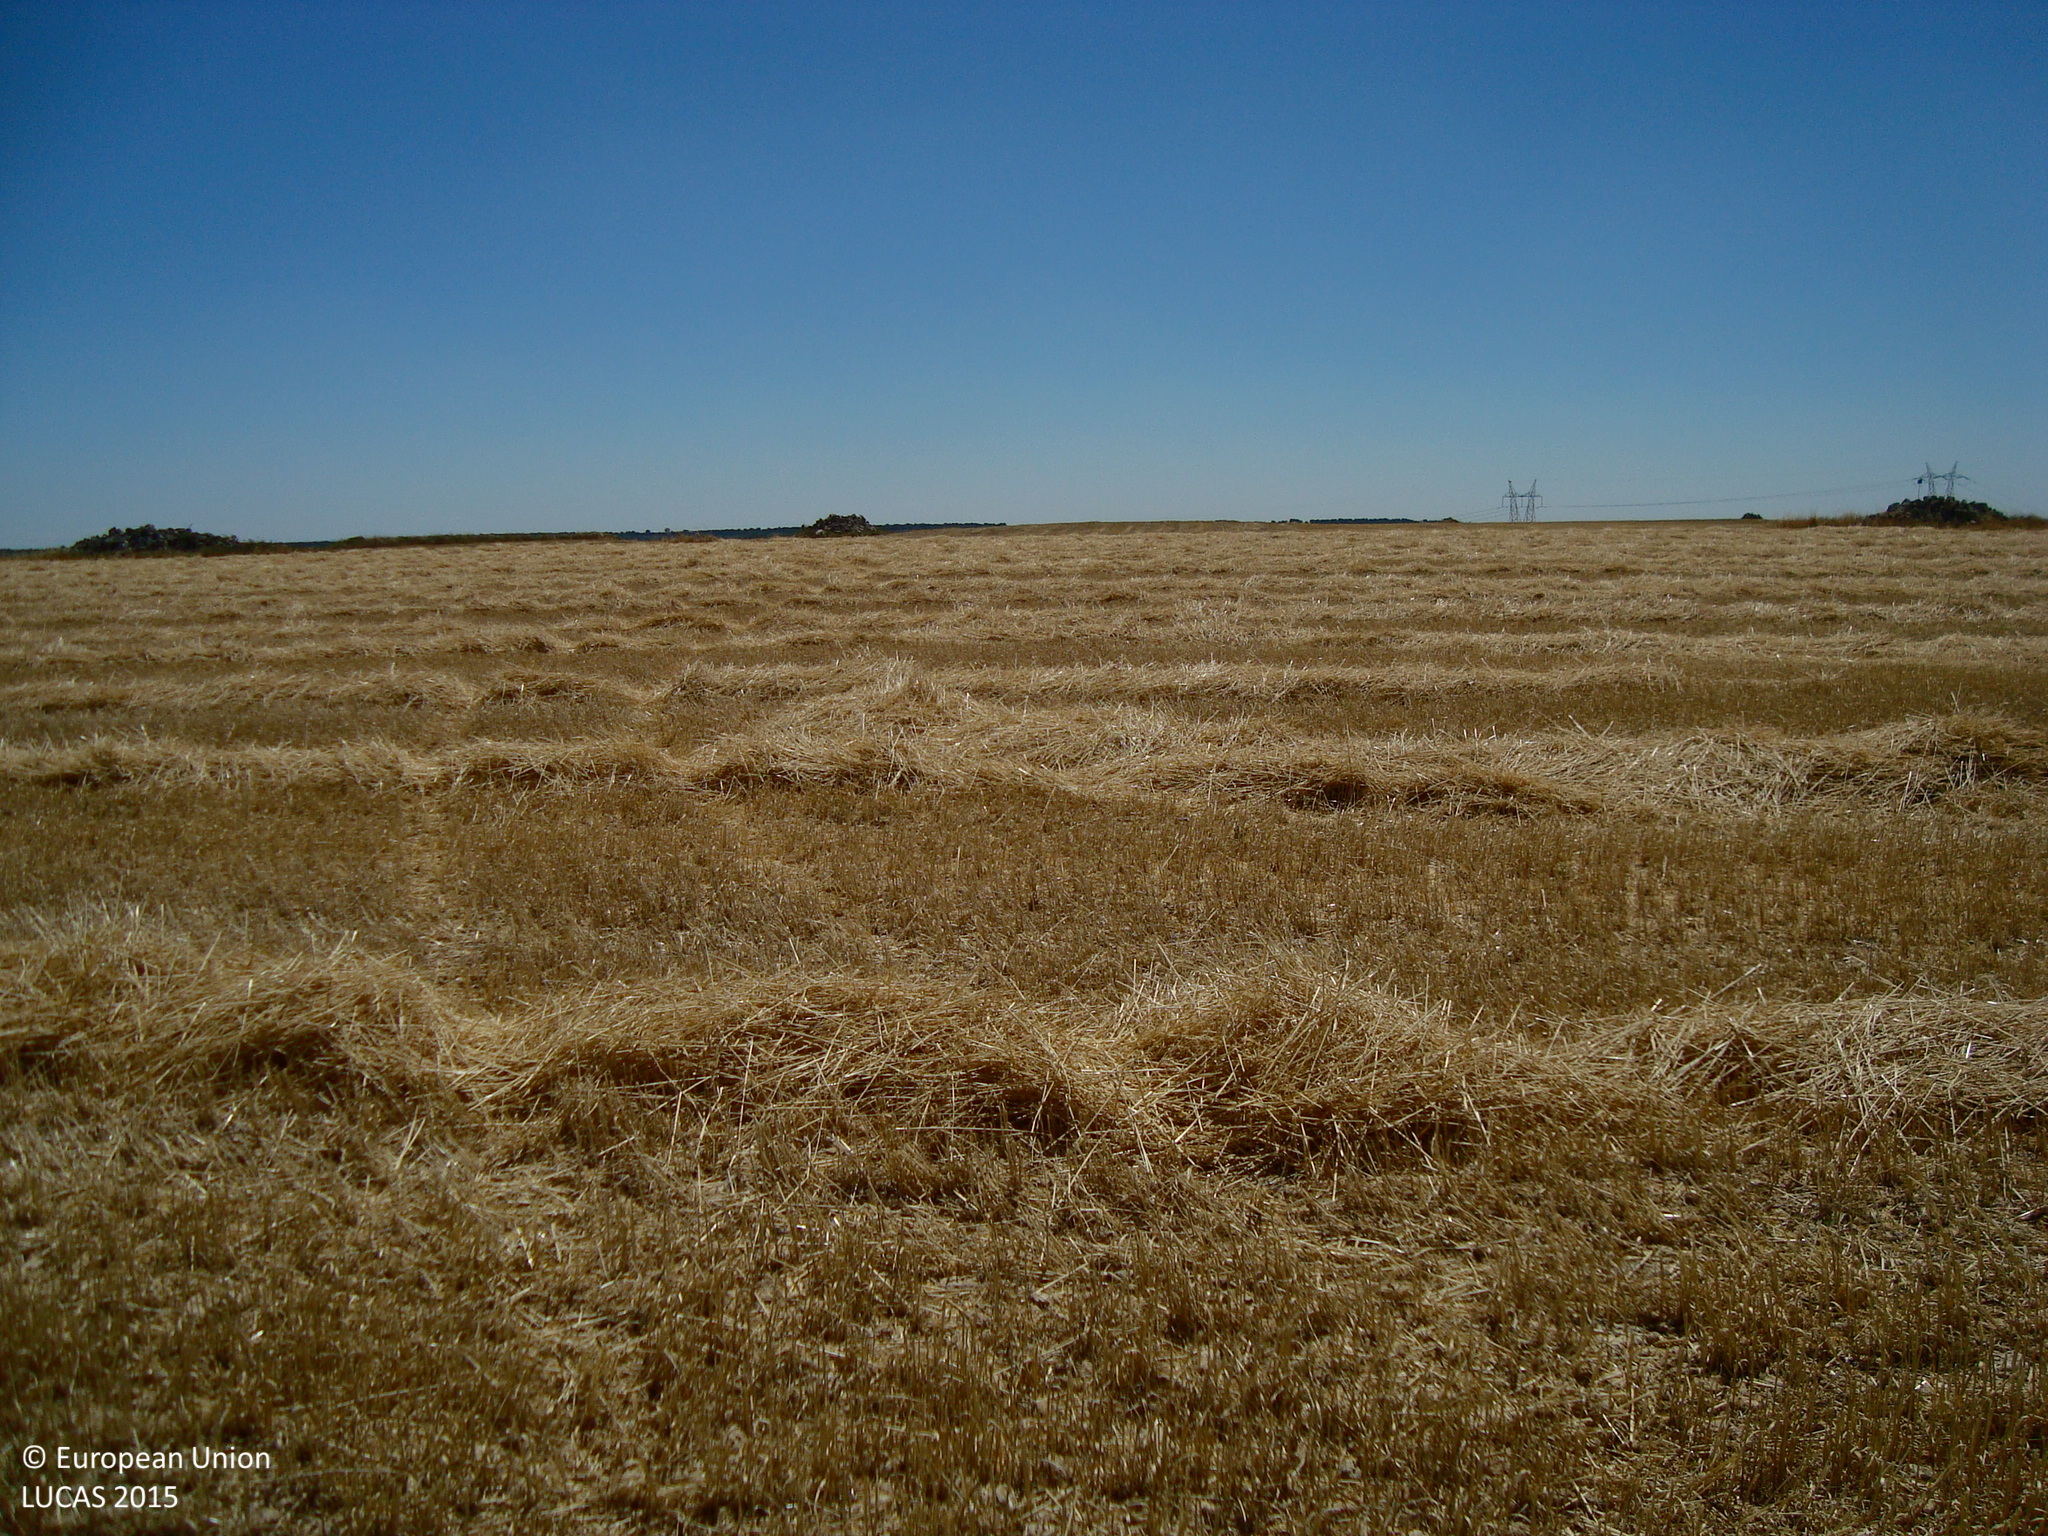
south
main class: Cropland
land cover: Common wheat
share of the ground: < 10 %
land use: Agriculture (excluding fallow land and kitchen gardens)
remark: Harvested field
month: July
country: ES
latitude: 42.2662
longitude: -3.9695
